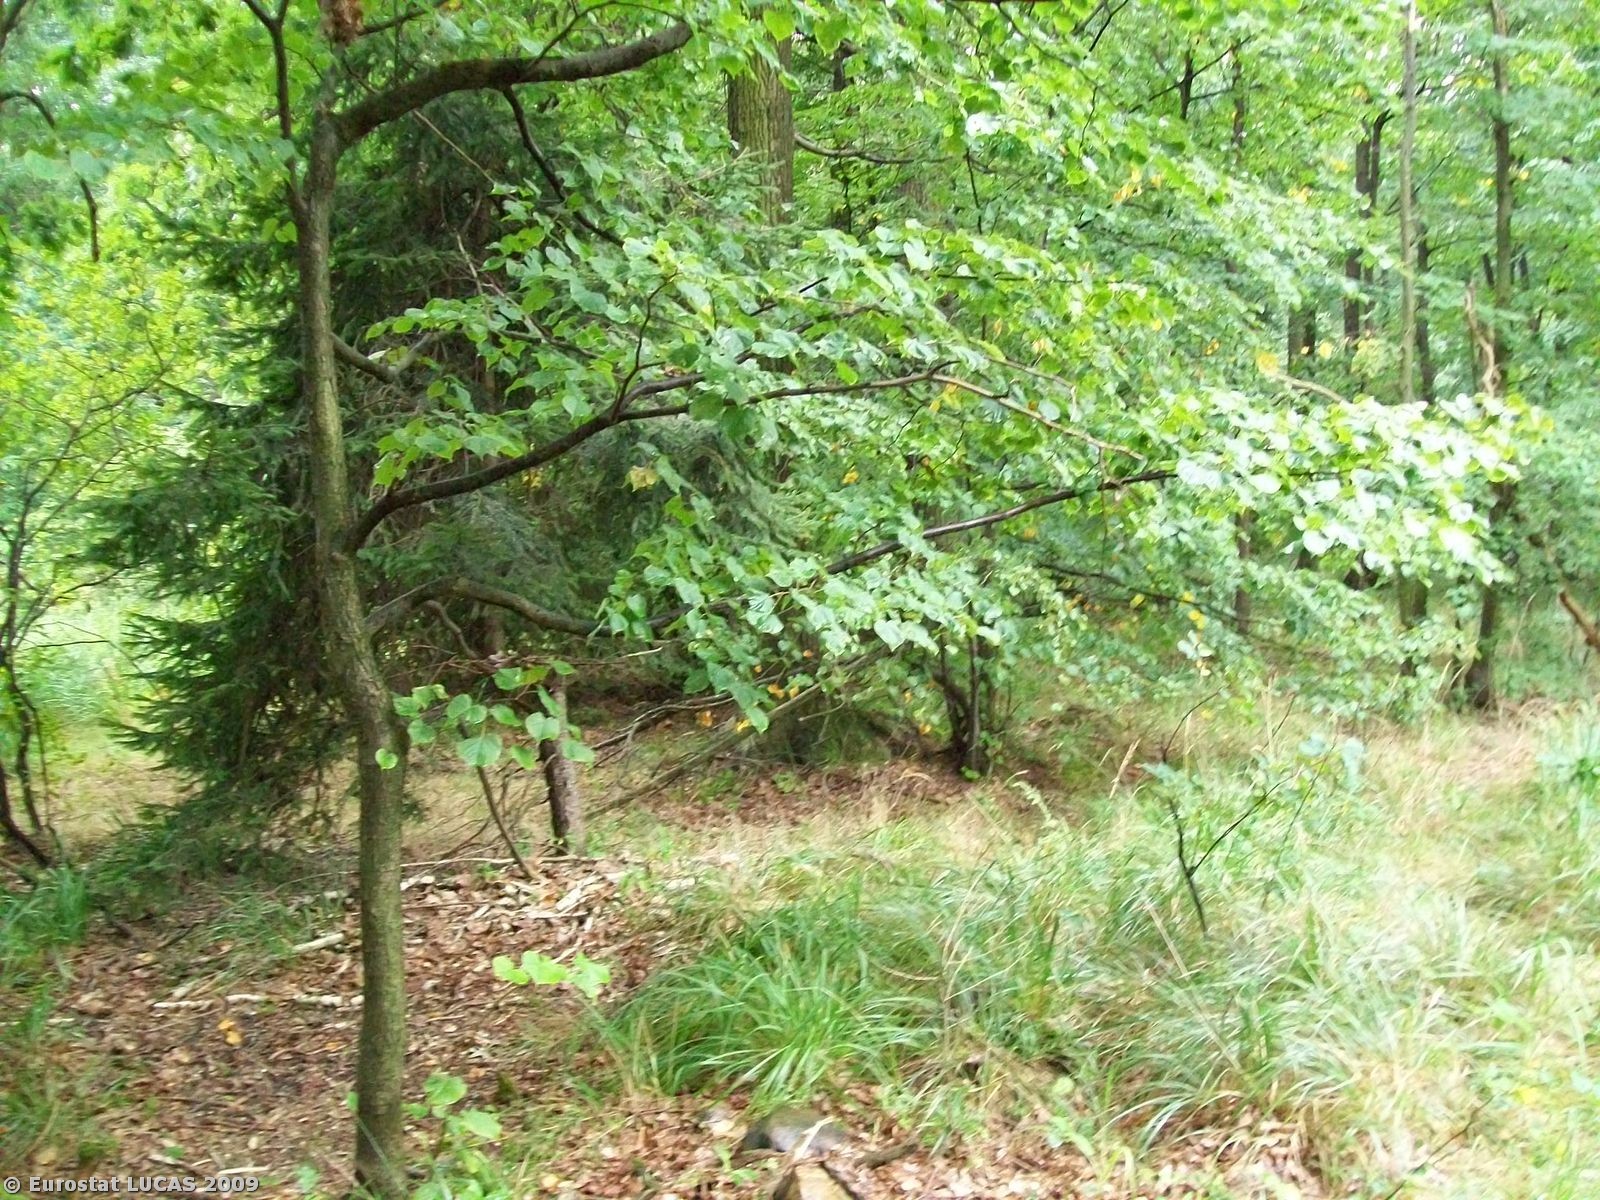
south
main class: Woodland
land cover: Mixed woodland
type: hemiboreal forest and nemoral coniferous forest and mixed broadleaved-coniferous forest
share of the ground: > 75 %
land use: Forestry
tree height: > 5 m
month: September
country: PL
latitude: 50.7409
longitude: 16.7684
